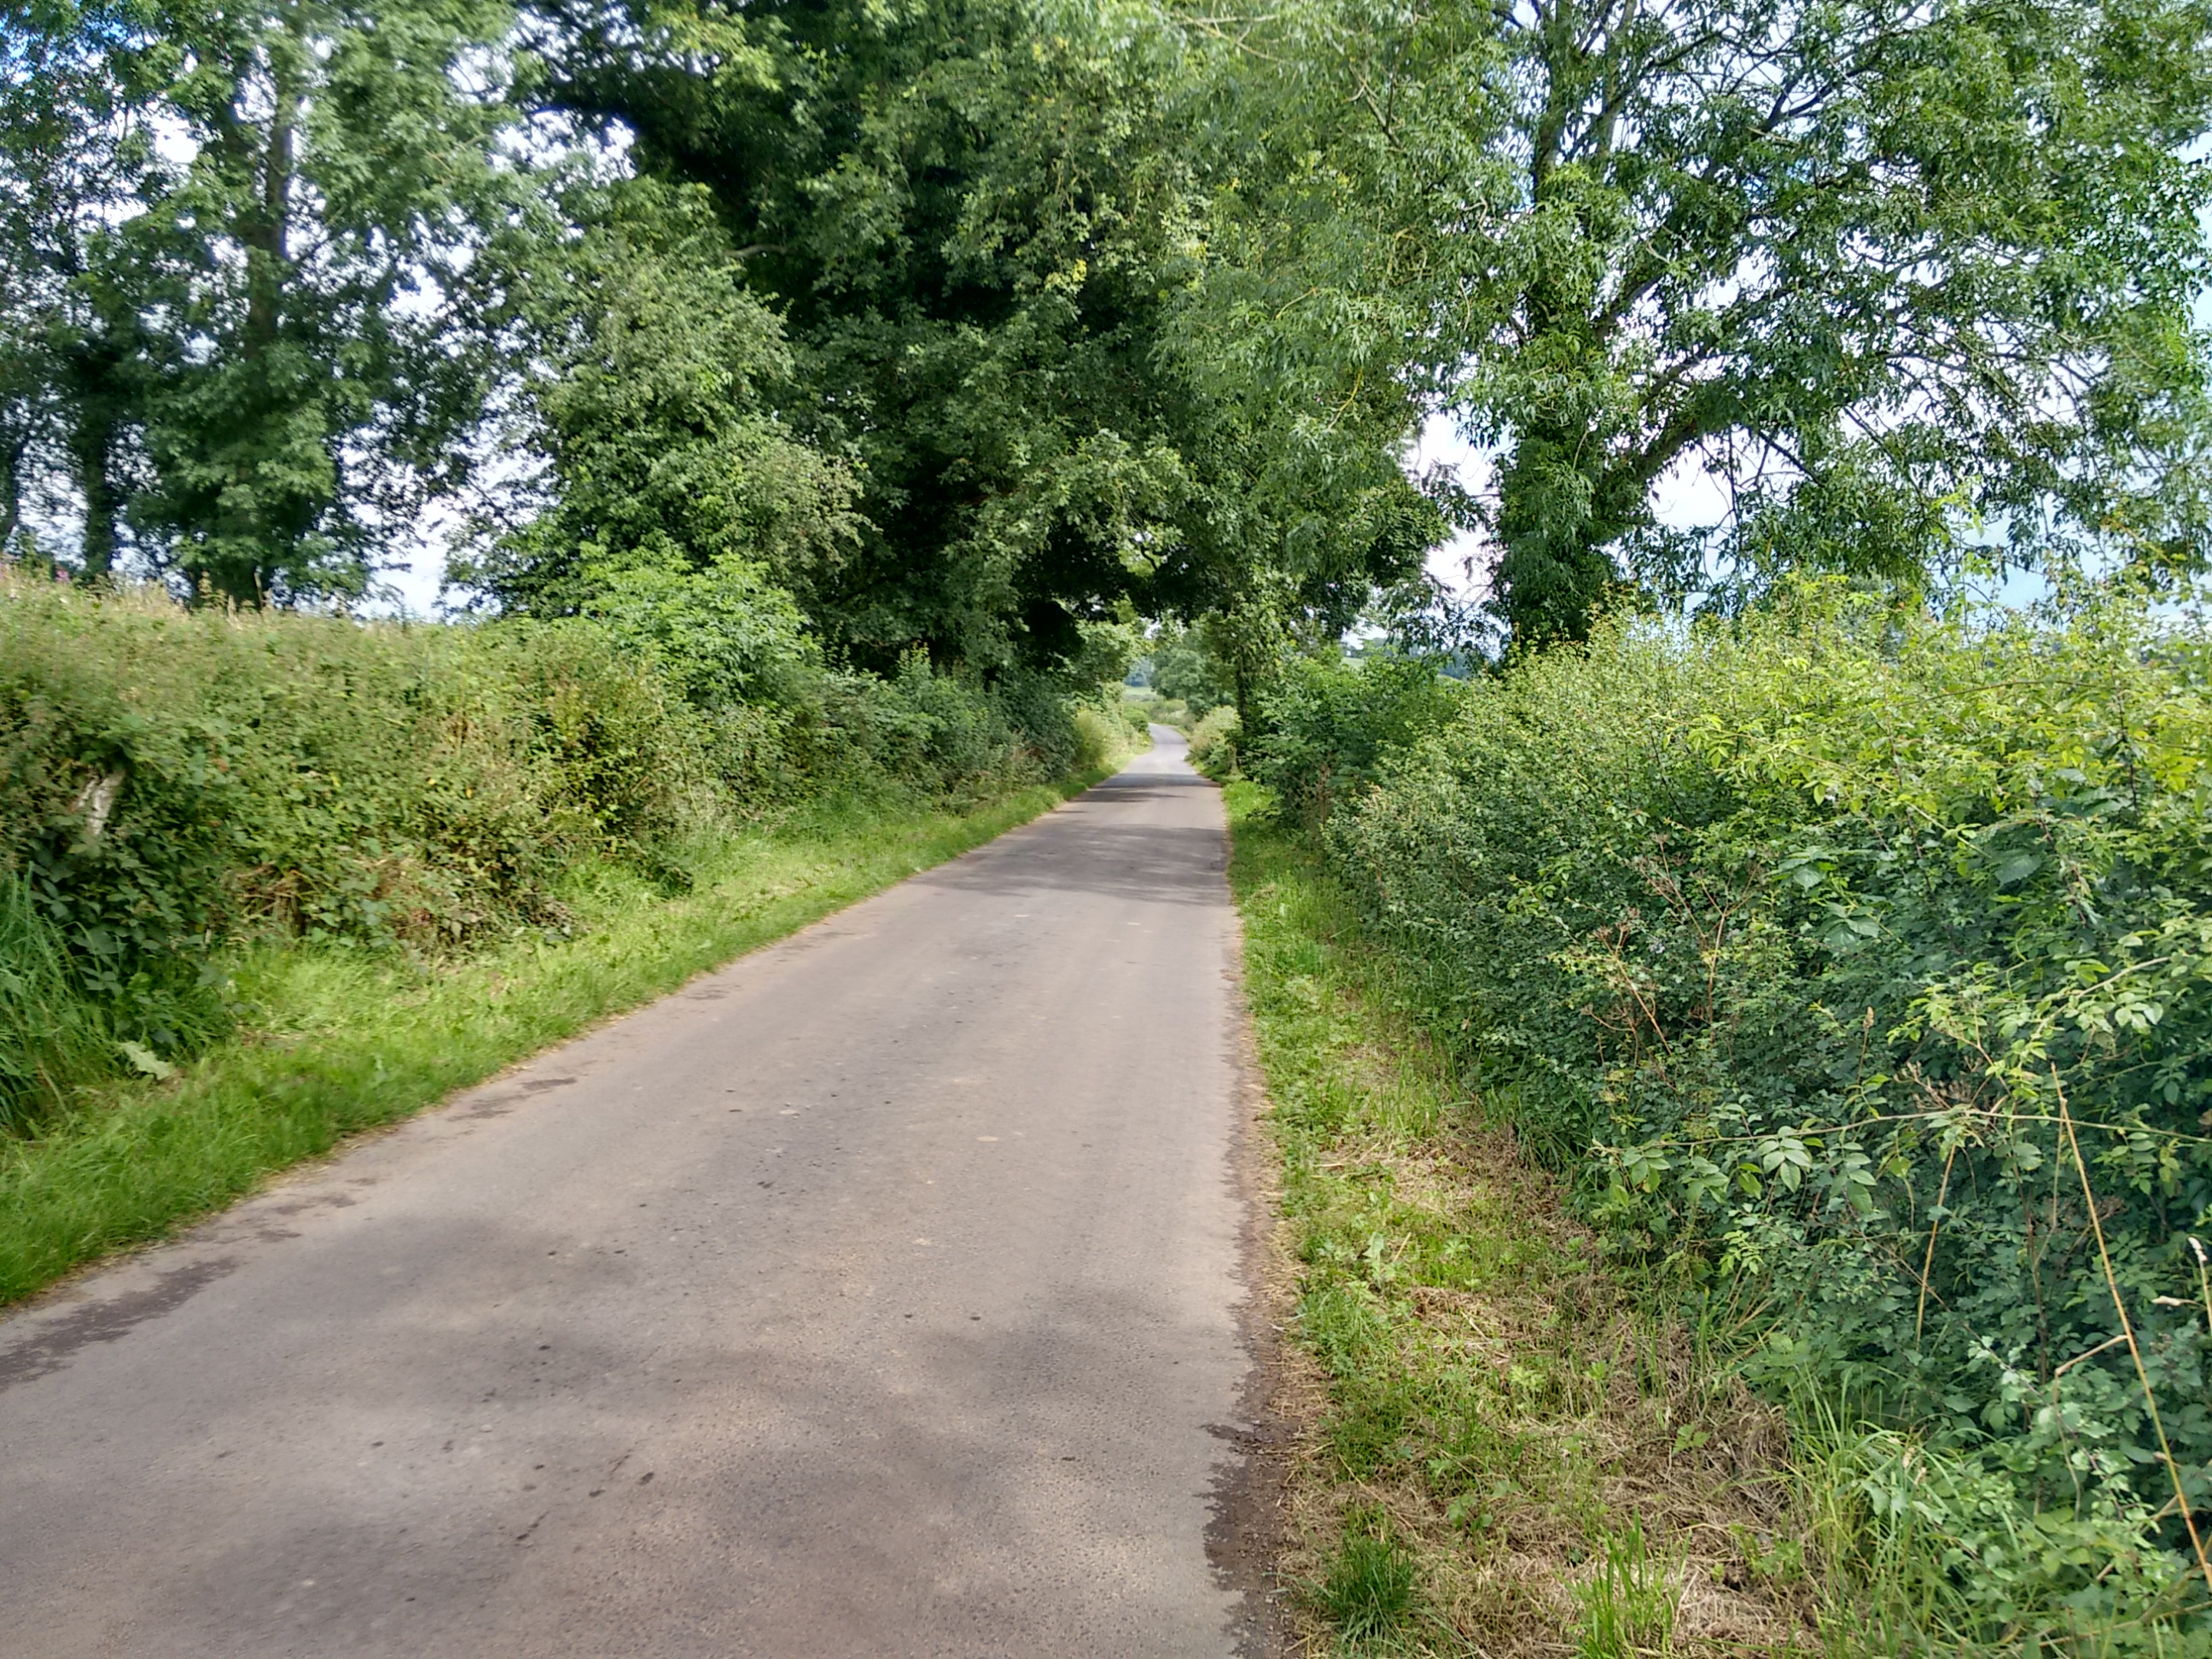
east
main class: Cropland
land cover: Other fresh vegetables
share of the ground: > 75 %
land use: Agriculture (excluding fallow land and kitchen gardens)
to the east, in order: Other fresh vegetables; Grassland without tree/shrub cover; Fences; Other fresh vegetables; Grass margins; Fences; Single bushes/trees; Rivers and streams; Abandoned hedges; Grassland without tree/shrub cover
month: August
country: GB
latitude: 54.3553
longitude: -6.8931
